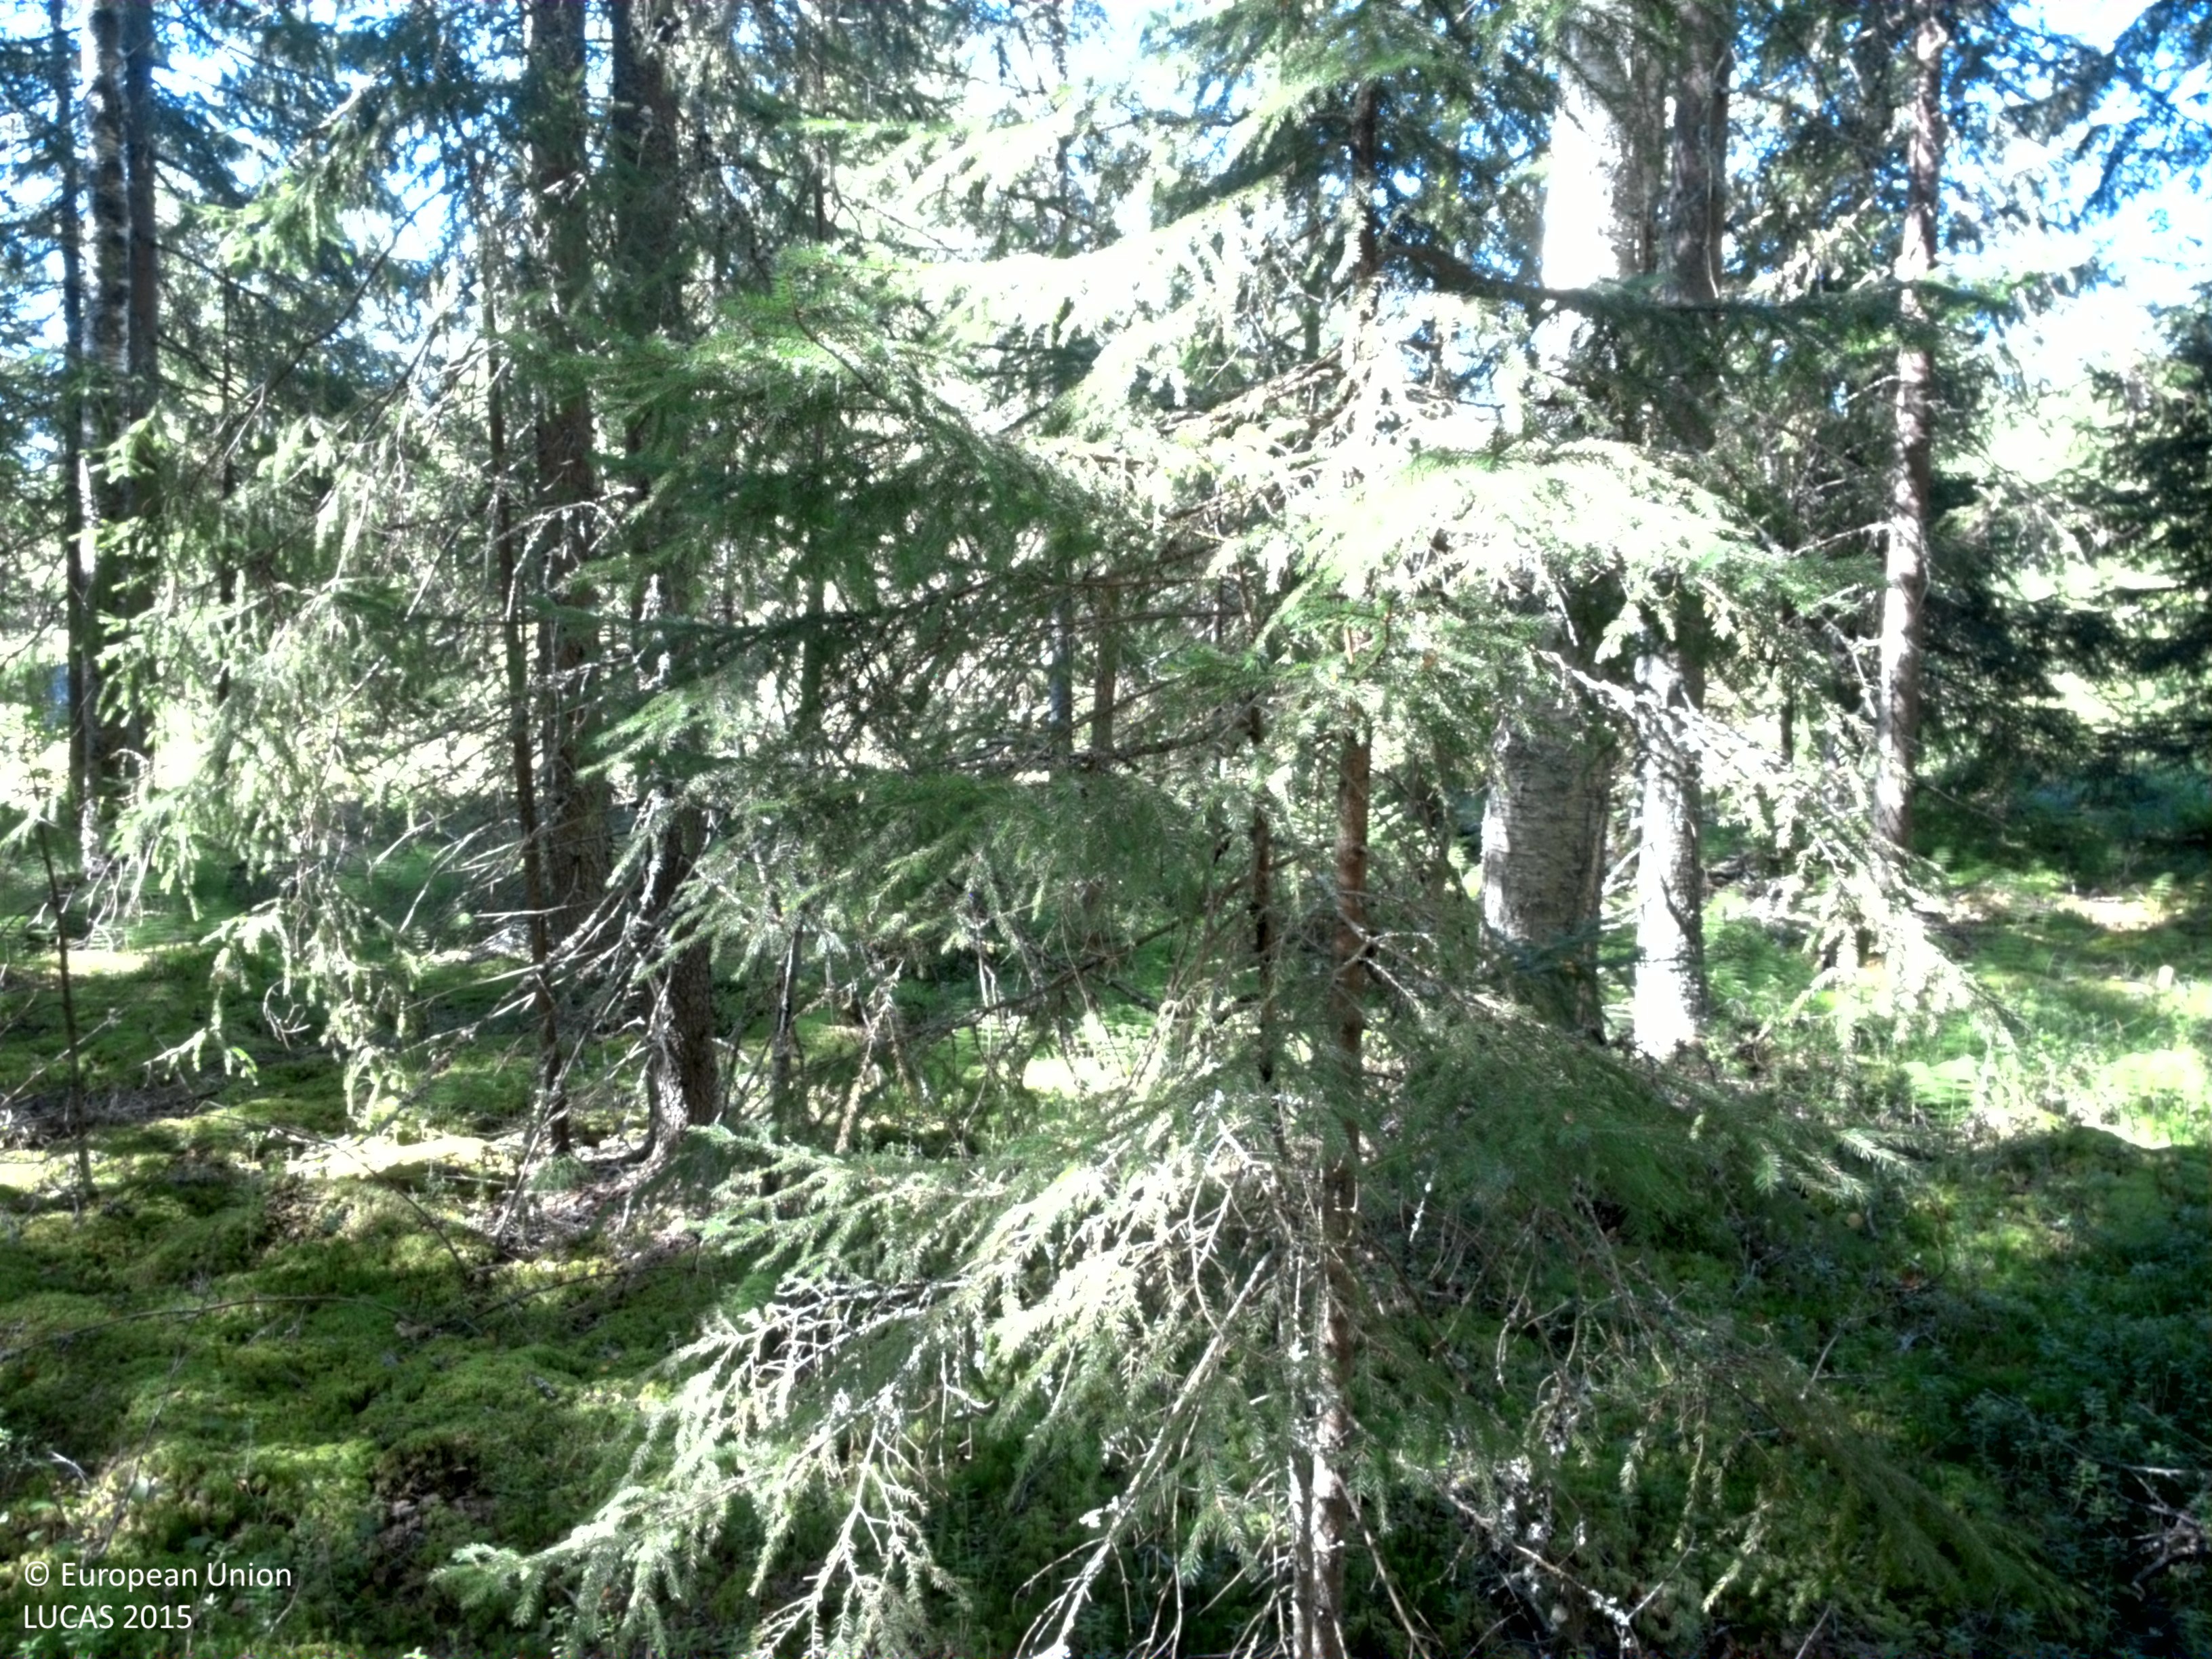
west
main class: Woodland
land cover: Spruce dominated coniferous woodland
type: boreal forest
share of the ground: > 75 %
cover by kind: coniferous forest trees 75 %, lichens and mosses 15 %, shrubs 10 %
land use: Forestry
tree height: > 5 m
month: August
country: SE
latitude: 59.6764
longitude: 15.9396
